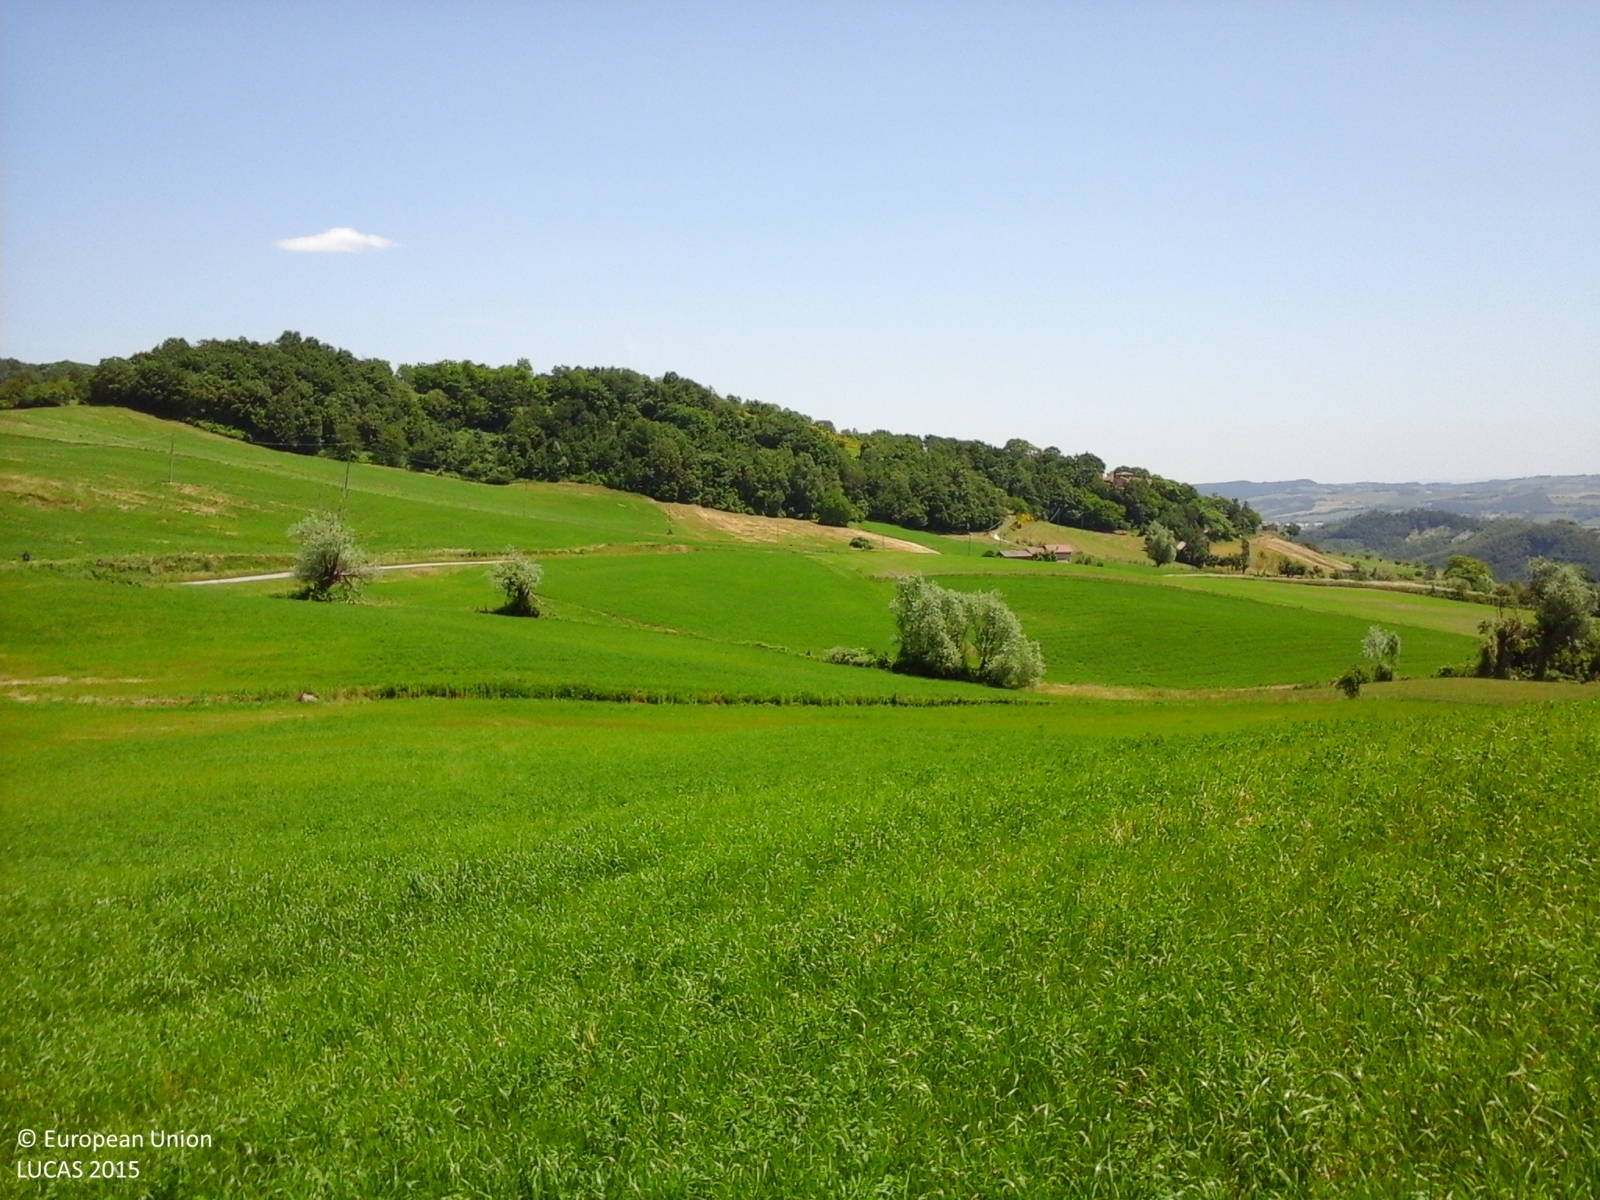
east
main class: Cropland
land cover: Lucerne
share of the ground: > 75 %
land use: Agriculture (excluding fallow land and kitchen gardens)
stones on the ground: < 10 %
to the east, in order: Lucerne; Ditches and canals; Lucerne; Managed hedges; Lucerne; Grassland without tree/shrub cover; Lucerne
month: May
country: IT
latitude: 44.7292
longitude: 10.0630
